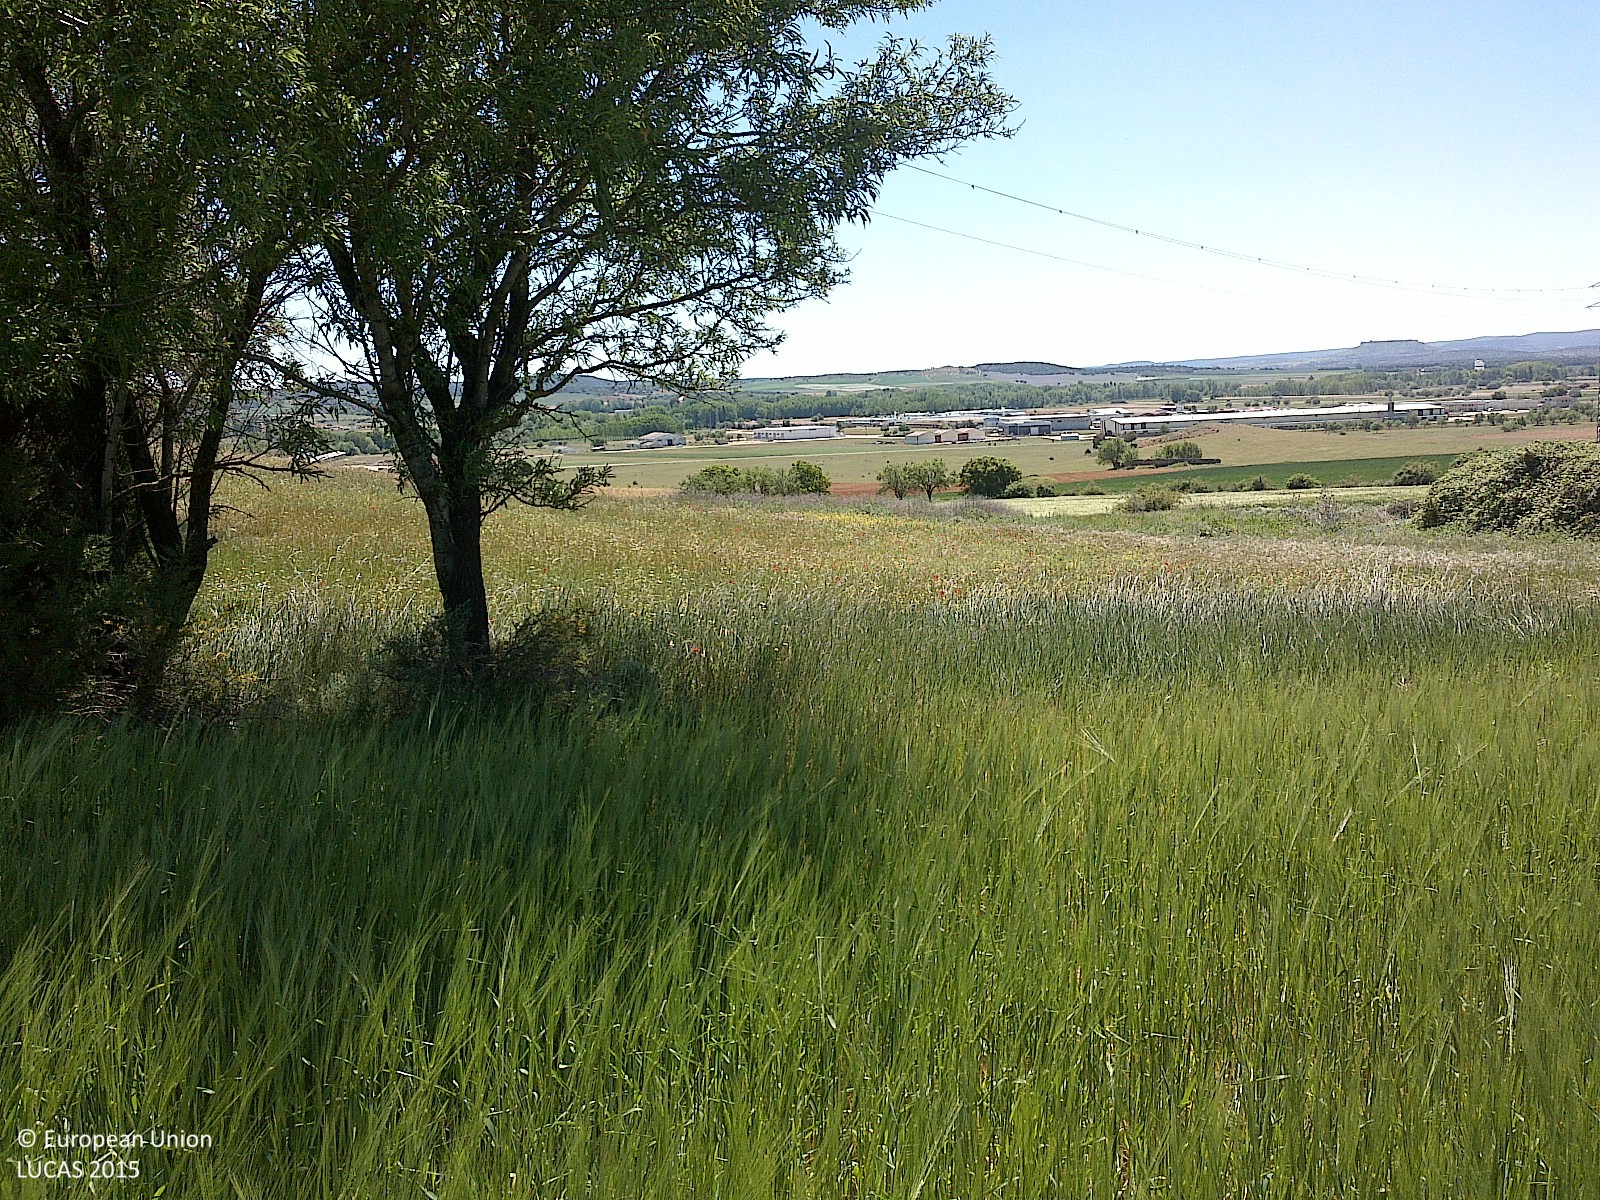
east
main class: Cropland
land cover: Barley
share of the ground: > 75 %
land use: Agriculture (excluding fallow land and kitchen gardens)
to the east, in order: Barley; Single bushes/trees; Grassland without tree/shrub cover; Electric lines; Spontaneously vegetated surfaces; Other bare soil; Spontaneously vegetated surfaces; Grass margins; Other bare soil
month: May
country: ES
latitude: 41.5614
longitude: -3.1015
